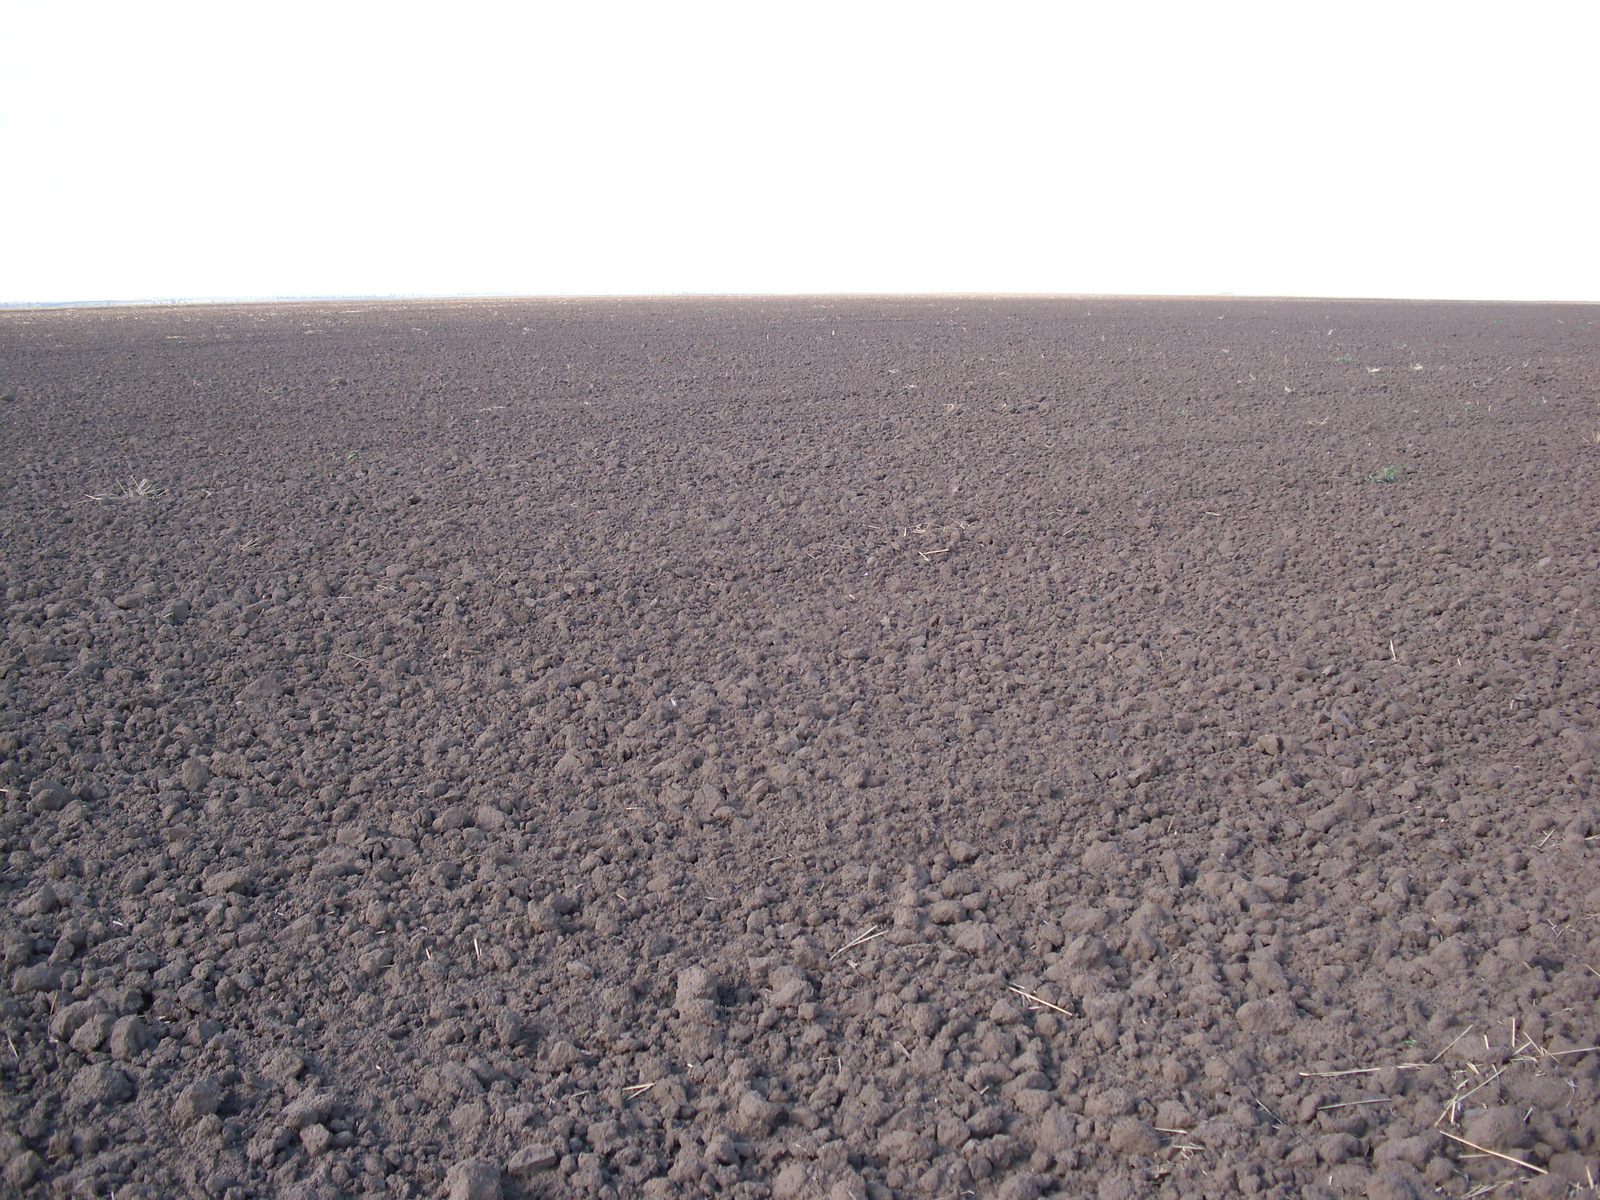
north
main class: Cropland
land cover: Common wheat
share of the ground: < 10 %
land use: Agriculture (excluding fallow land and kitchen gardens)
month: August
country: BG
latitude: 43.7466
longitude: 23.2938
